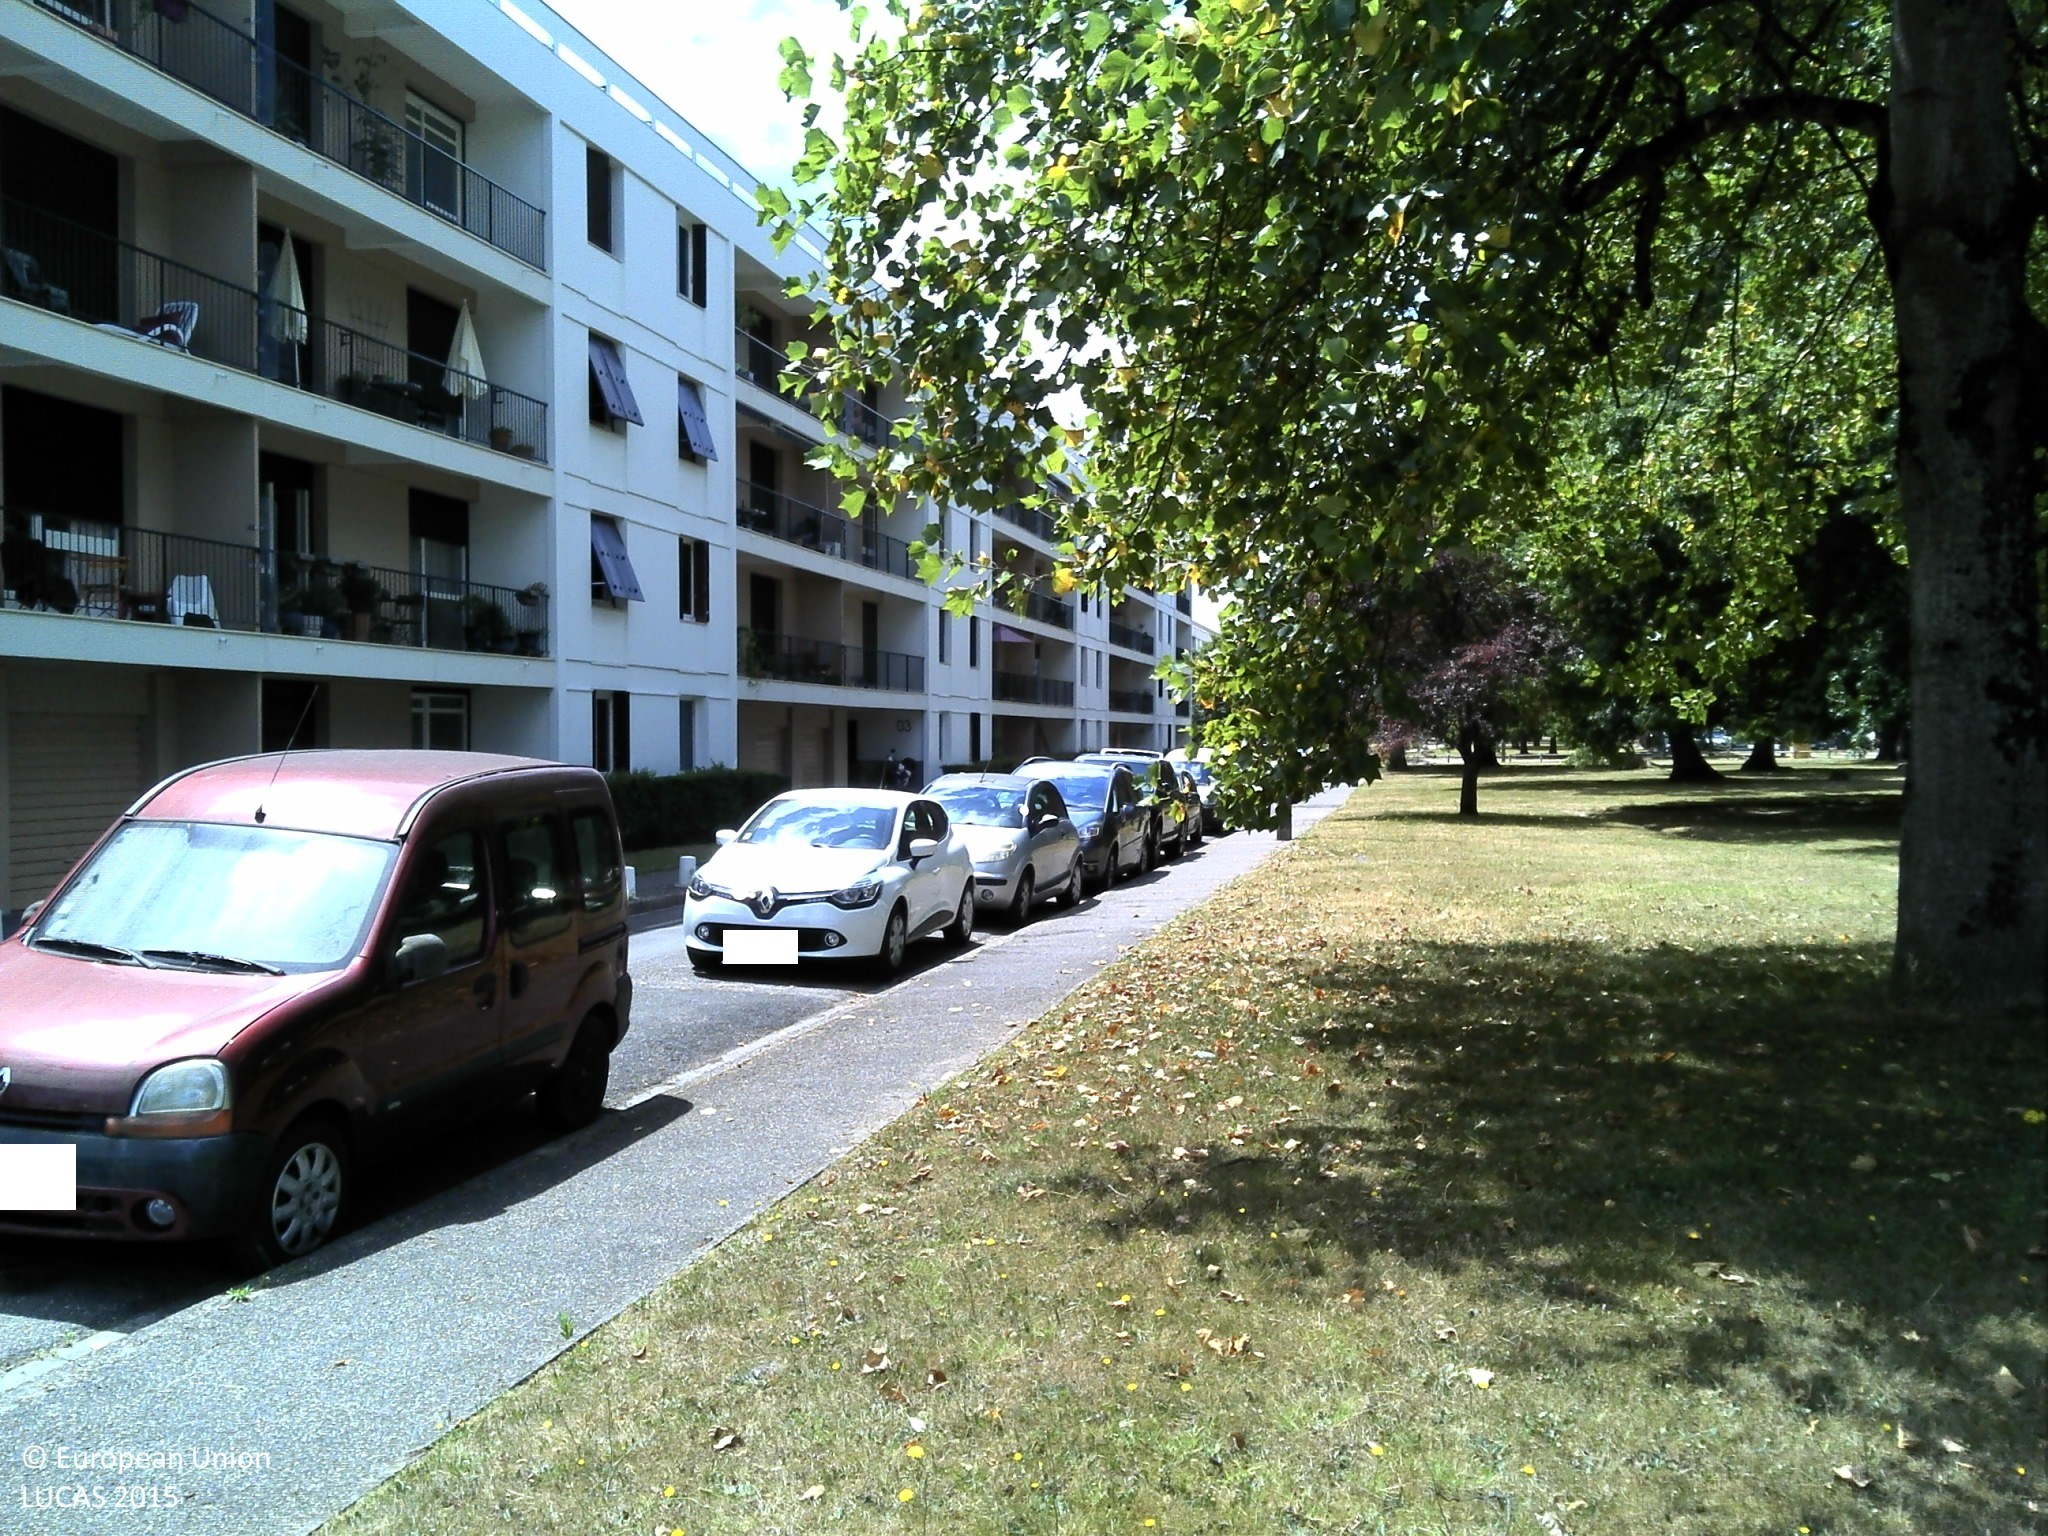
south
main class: Grassland
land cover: Grassland with sparse tree/shrub cover
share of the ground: > 75 %
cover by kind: herbaceous plants 95 %, broadleaved forest trees 5 %
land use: Amenities, museums, leisure
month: July
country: FR
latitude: 44.8565
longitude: -0.6362
